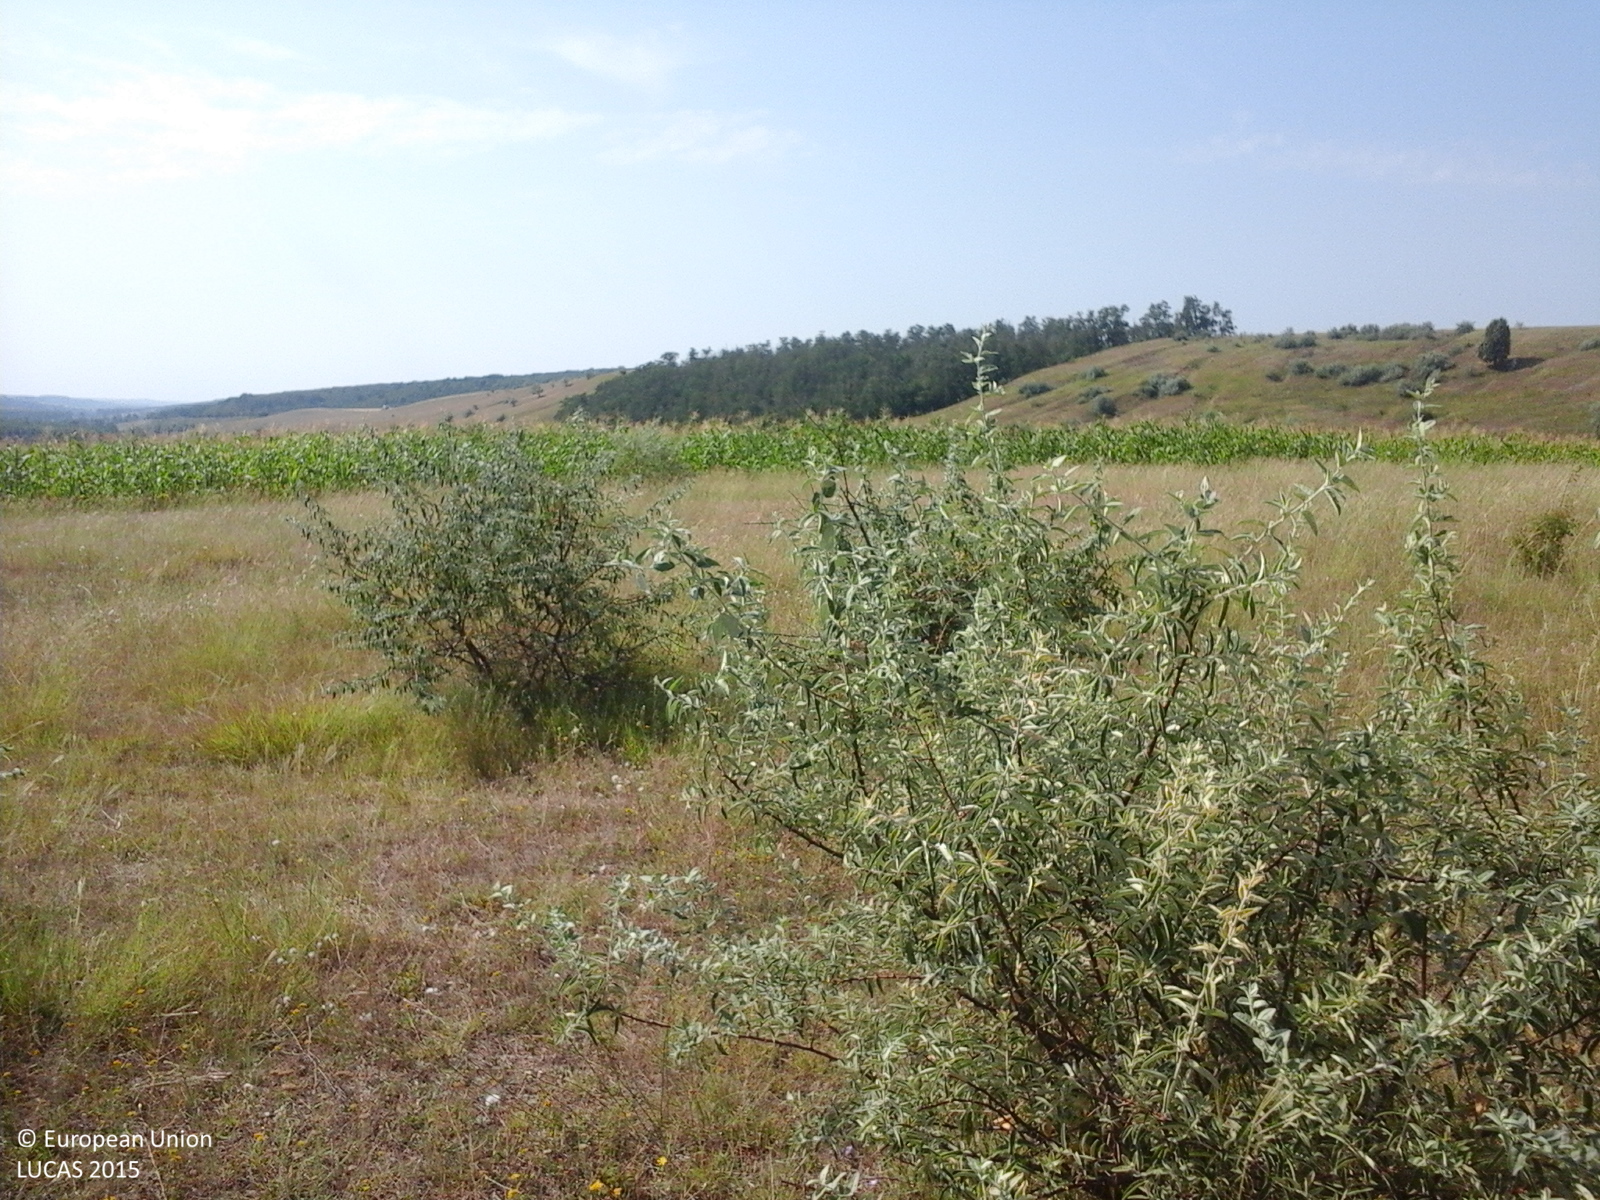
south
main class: Grassland
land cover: Grassland with sparse tree/shrub cover
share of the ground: > 75 %
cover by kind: herbaceous plants 95 %, broadleaved forest trees 5 %
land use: Agriculture (excluding fallow land and kitchen gardens)
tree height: > 5 m
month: July
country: RO
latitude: 46.0525
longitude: 27.8372
